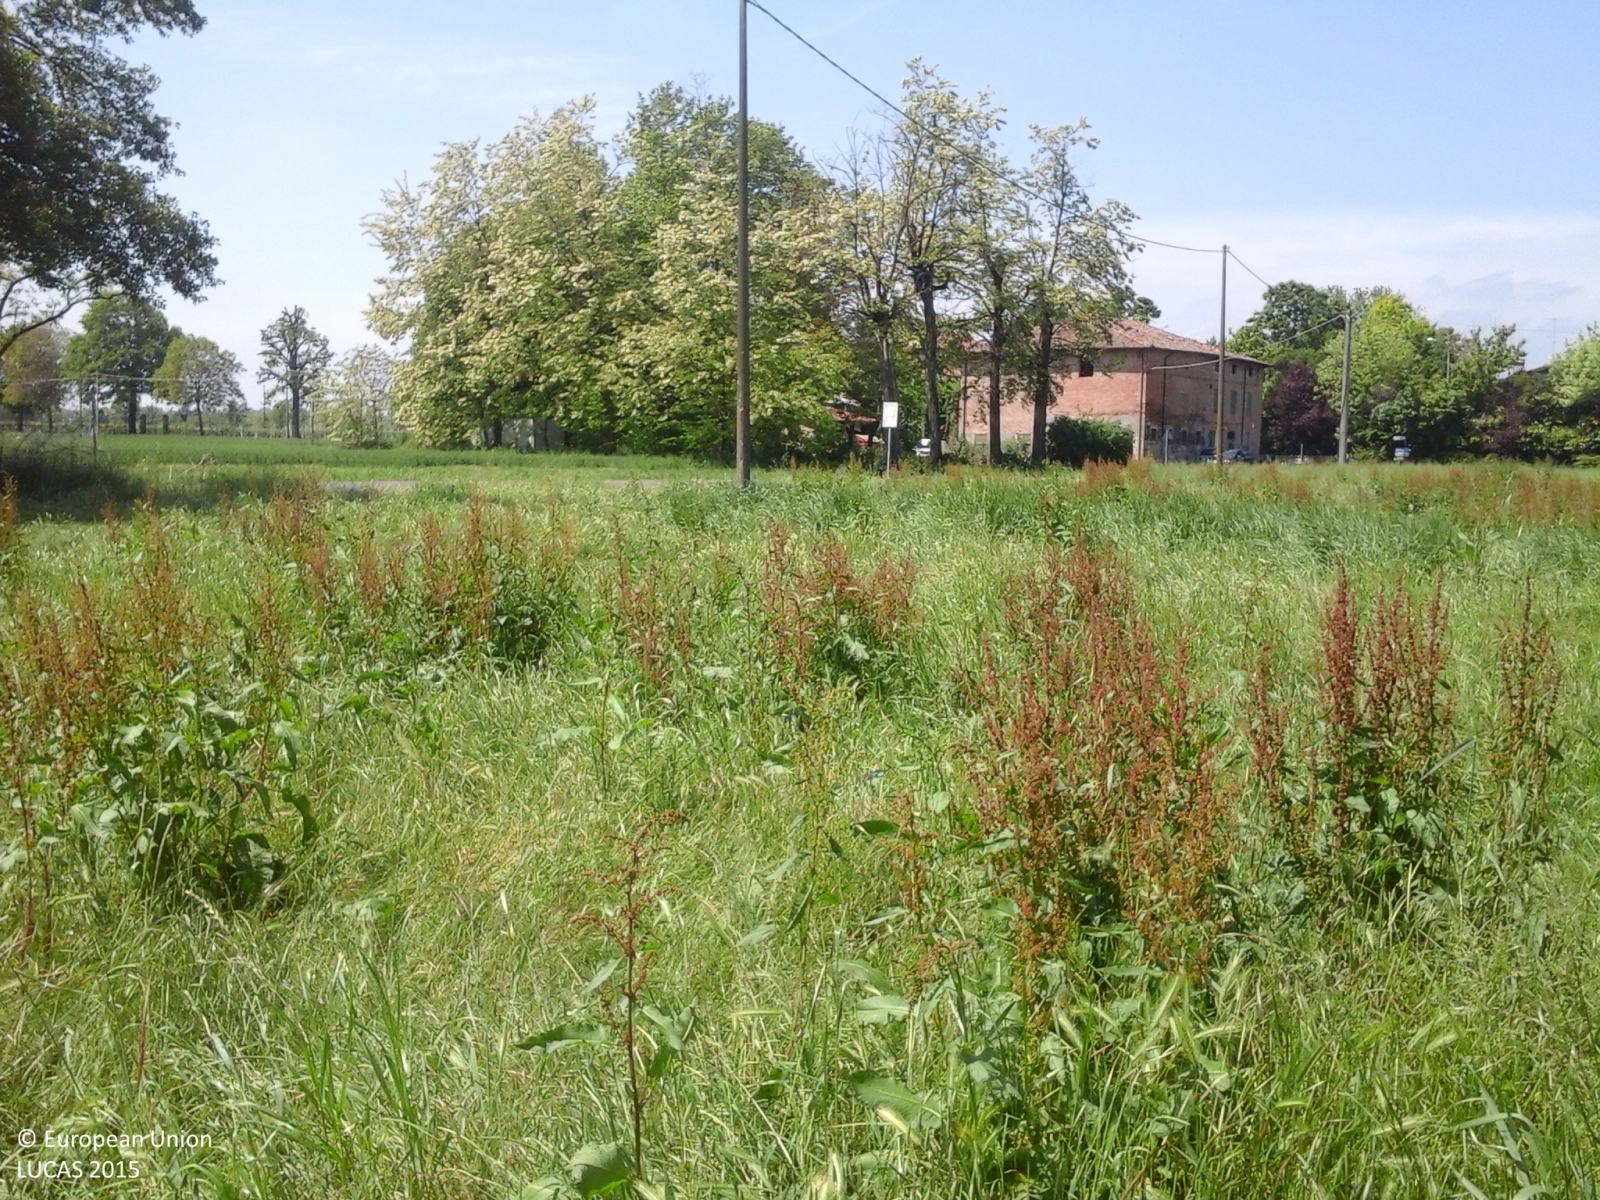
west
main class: Grassland
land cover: Spontaneously vegetated surfaces
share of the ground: > 75 %
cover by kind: herbaceous plants 100 %
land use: Agriculture (excluding fallow land and kitchen gardens)
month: May
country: IT
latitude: 44.5634
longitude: 10.8669
